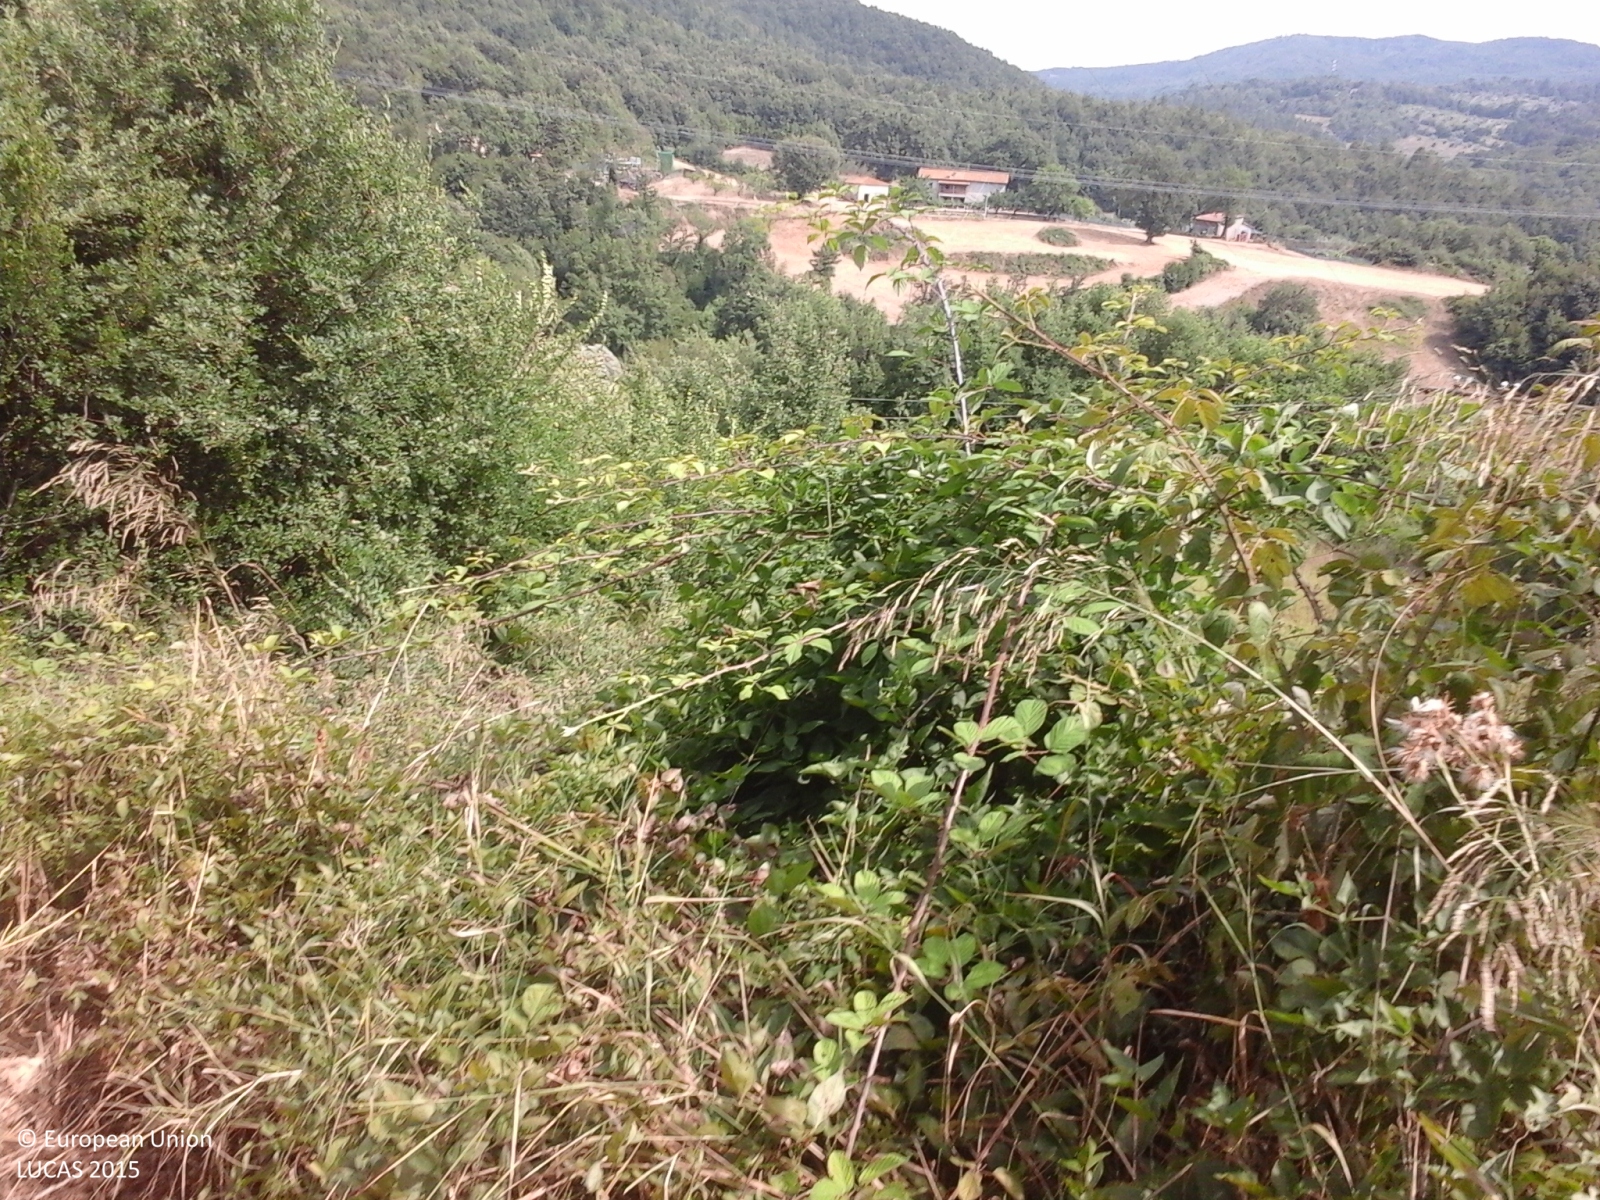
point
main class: Woodland
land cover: Broadleaved woodland
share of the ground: > 75 %
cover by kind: broadleaved forest trees 100 %
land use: Forestry
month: August
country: IT
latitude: 43.1922
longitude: 10.8465
